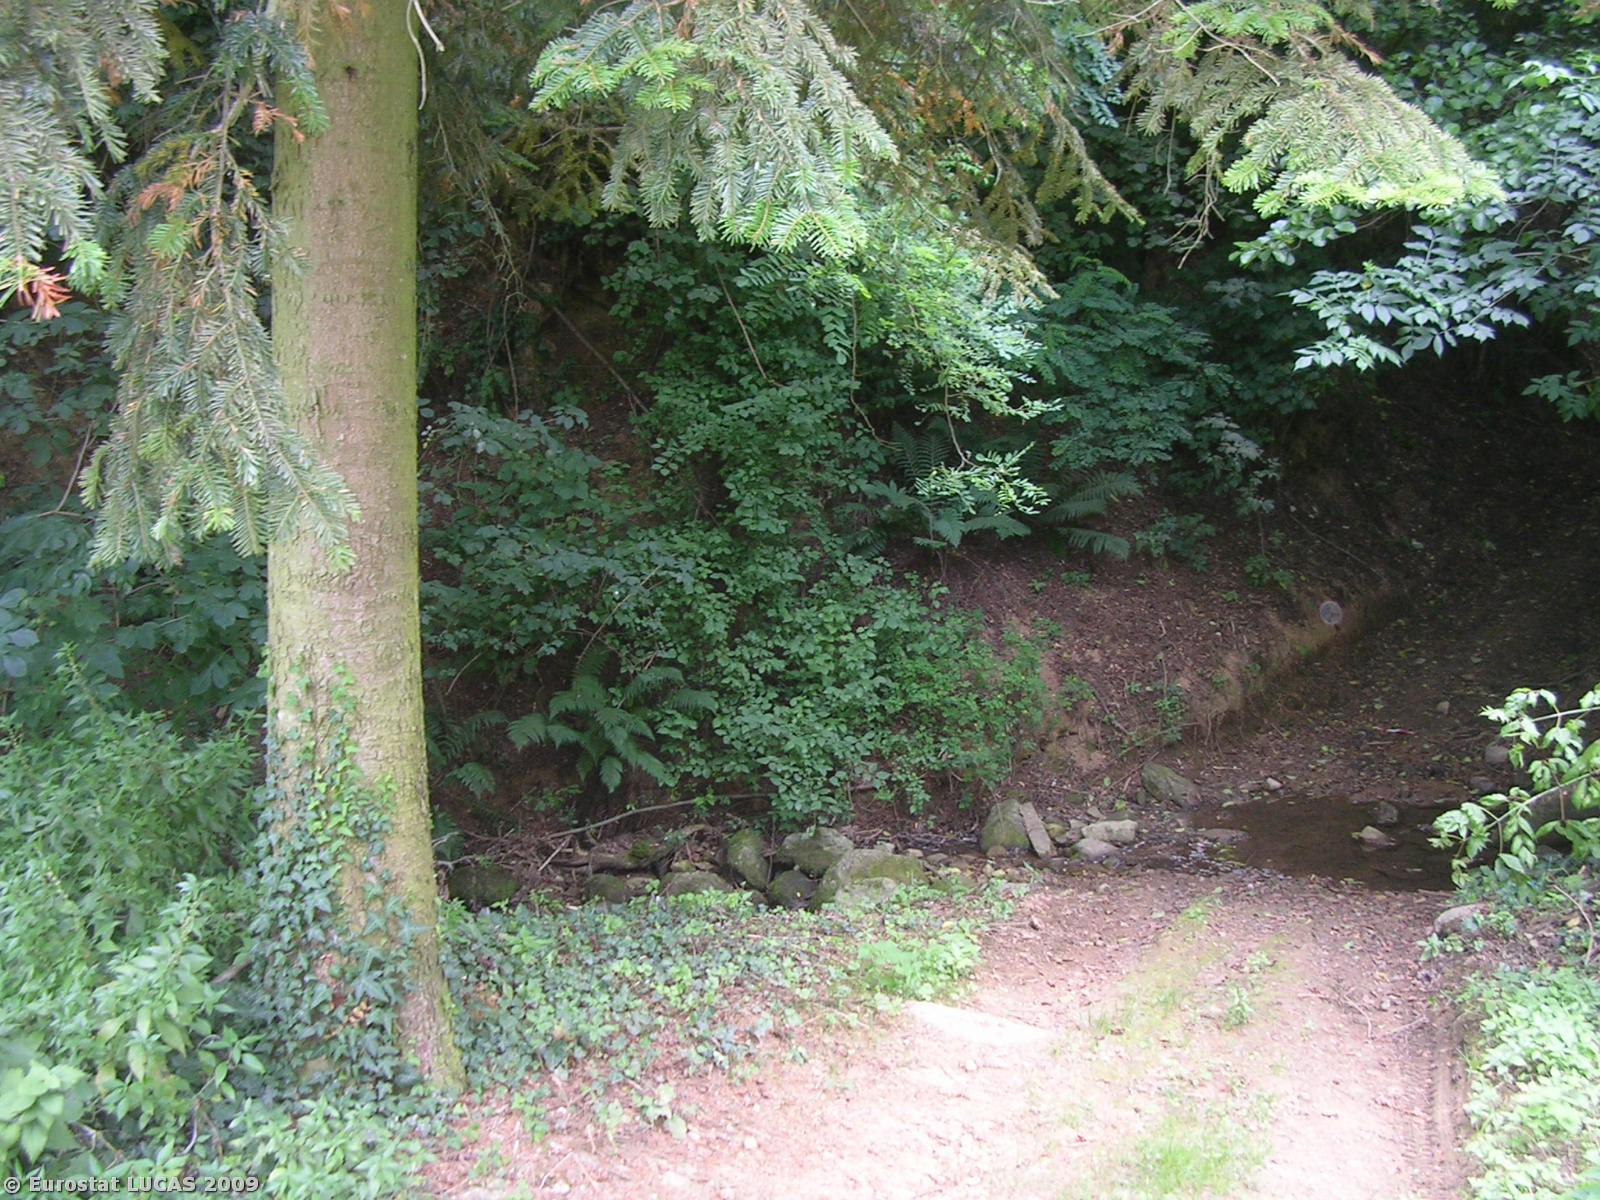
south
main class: Woodland
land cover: Mixed woodland
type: mesophytic deciduous forest
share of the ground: > 75 %
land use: Forestry
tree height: > 5 m
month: July
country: IT
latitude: 45.3102
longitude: 11.7189
